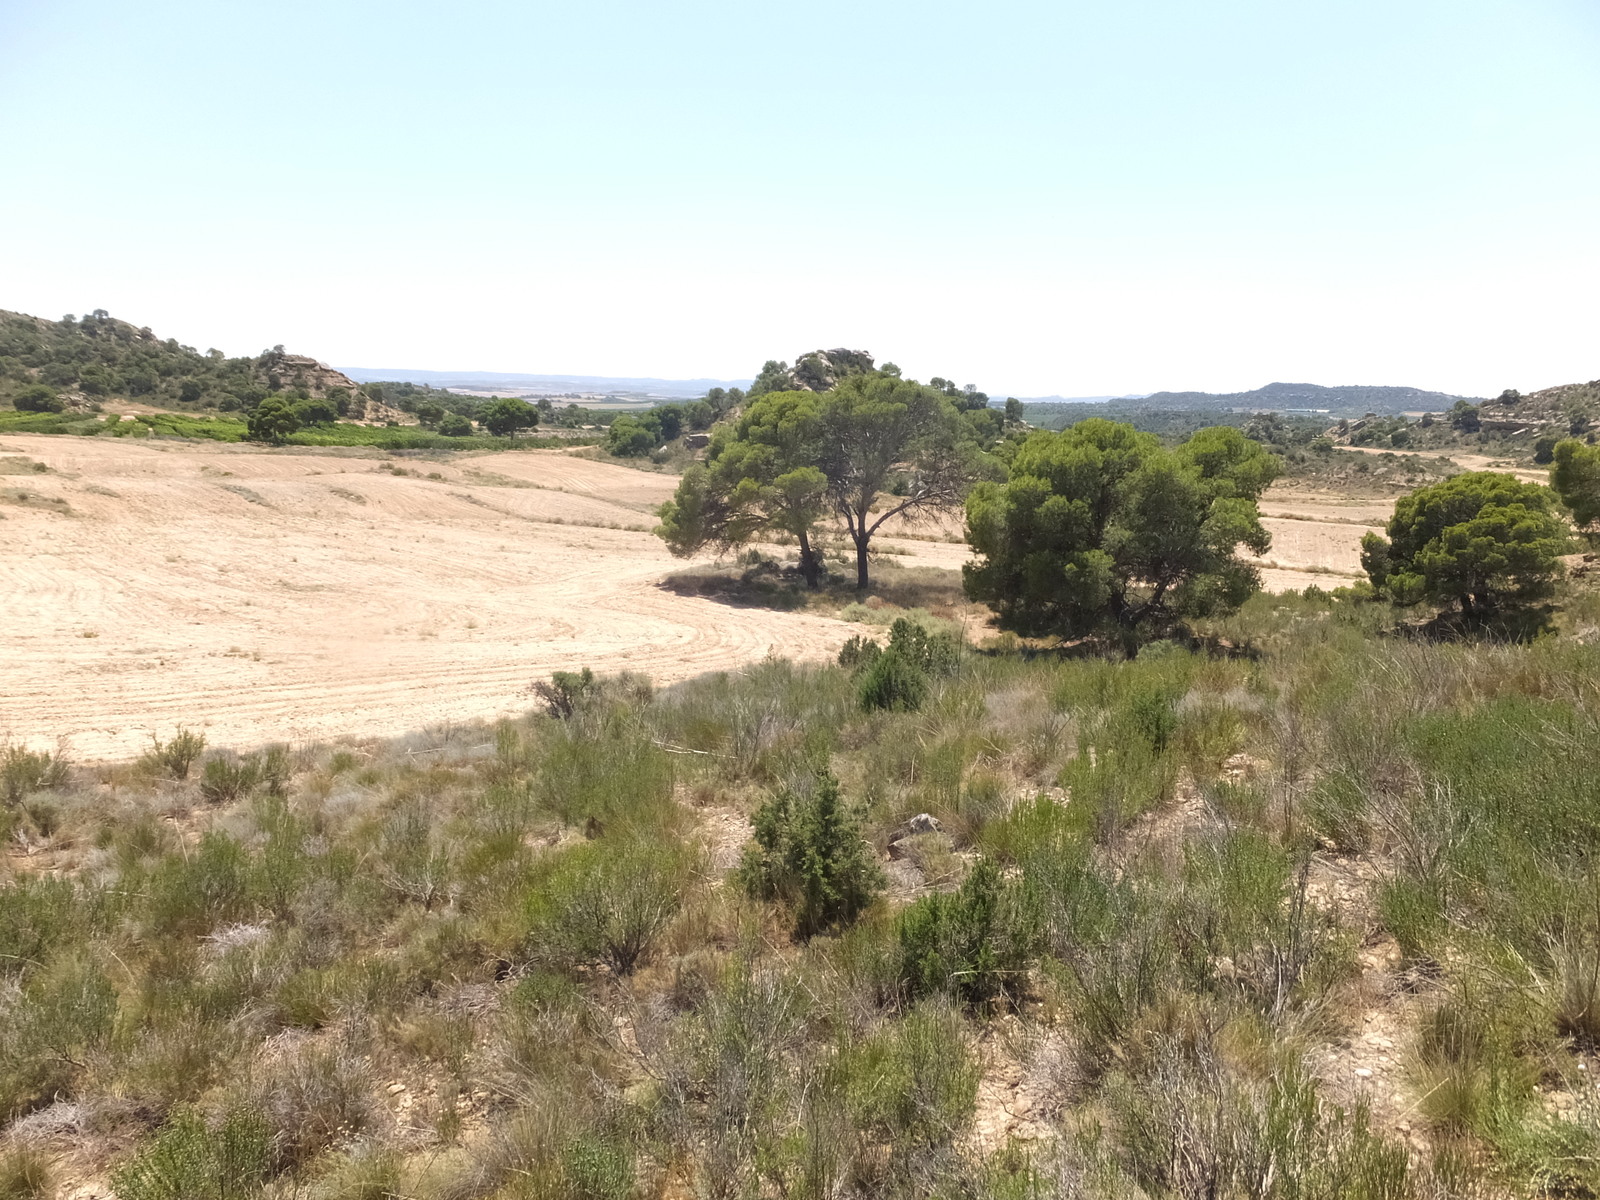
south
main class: Shrubland
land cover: Shrubland with sparse tree cover
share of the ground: > 75 %
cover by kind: shrubs 50 %, herbaceous plants 30 %, unconsolidated bare surface 10 %, coniferous forest trees 5 %, consolidated bare surface 5 %
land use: Semi-natural and natural areas not in use
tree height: < 5 m
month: June
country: ES
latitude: 41.3031
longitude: -0.1777
